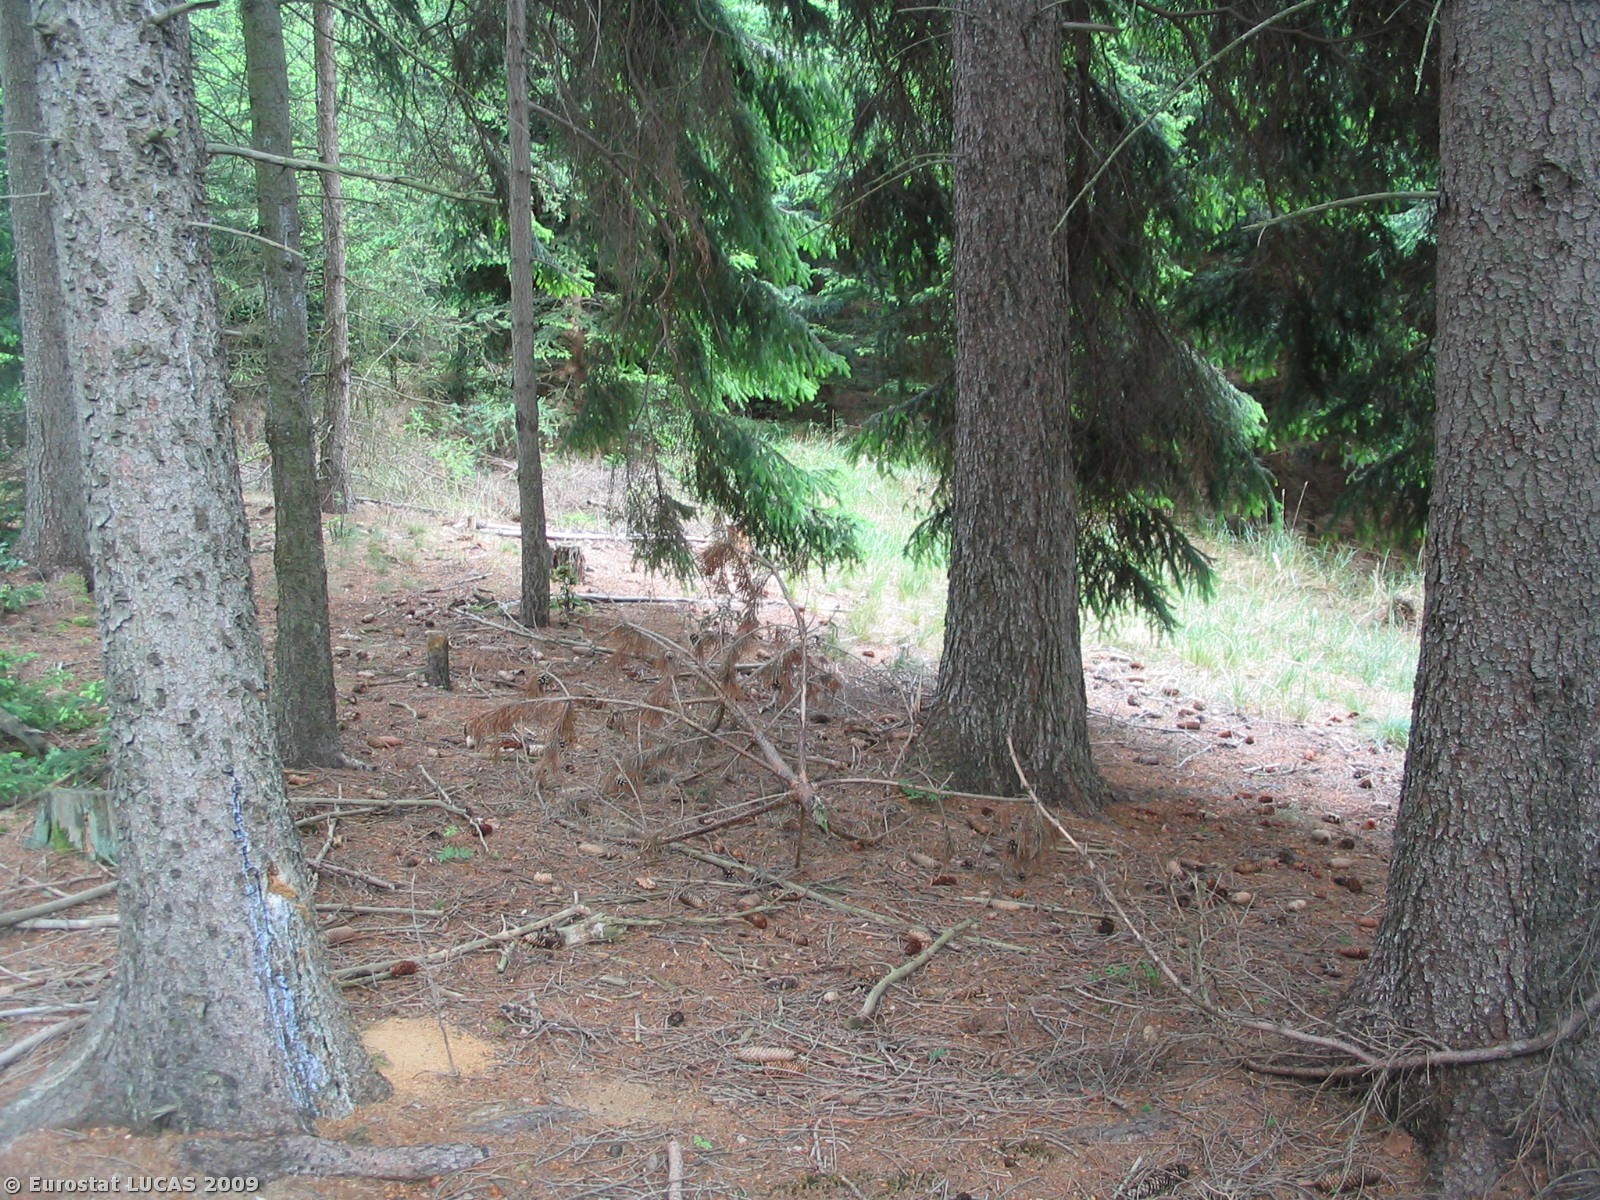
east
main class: Woodland
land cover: Coniferous woodland
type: hemiboreal forest and nemoral coniferous forest and mixed broadleaved-coniferous forest
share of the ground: > 75 %
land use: Forestry
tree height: > 5 m
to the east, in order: Coniferous woodland; Tracks; Mixed woodland; Tracks; Mixed woodland
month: May
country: CZ
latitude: 49.4409
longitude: 16.4752
